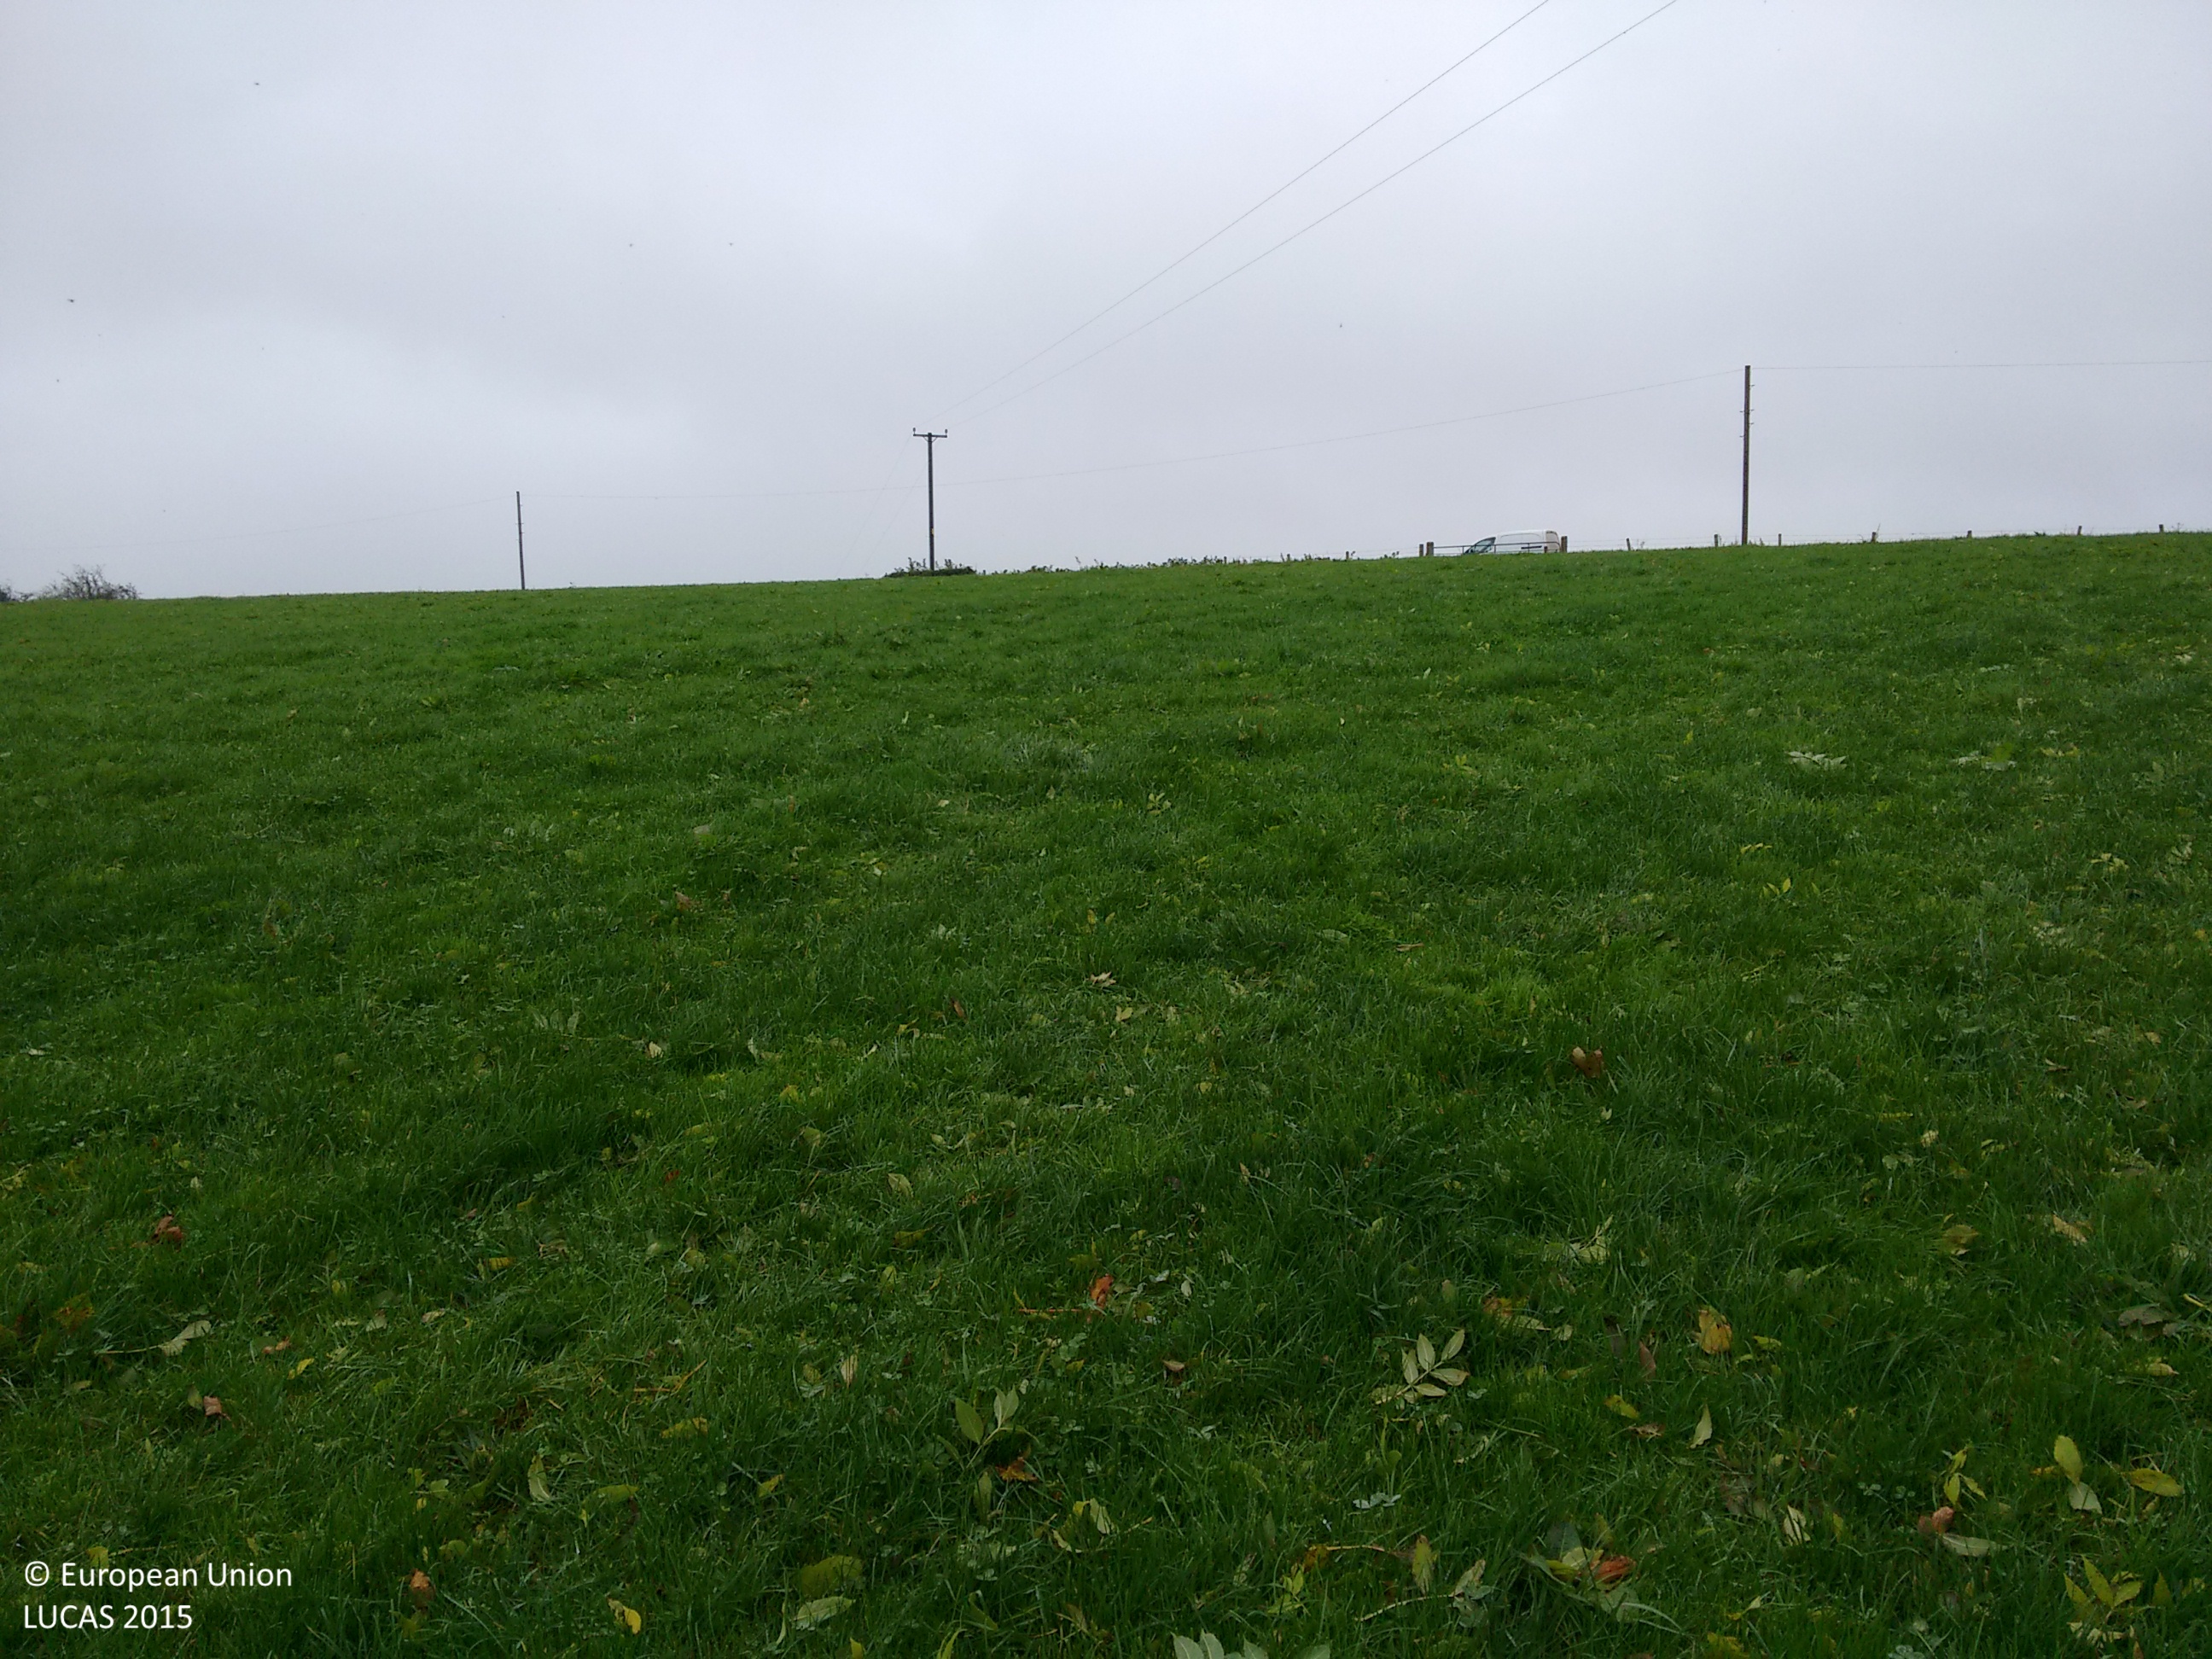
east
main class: Grassland
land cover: Grassland without tree/shrub cover
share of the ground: > 75 %
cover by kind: herbaceous plants 100 %
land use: Agriculture (excluding fallow land and kitchen gardens)
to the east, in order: Grassland without tree/shrub cover; Electric lines; Grassland without tree/shrub cover; Fences; Dry stone walls; Grass margins; Paved roads, cycling and walking lanes; Electric lines; Dry stone walls; Fences; Grassland without tree/shrub cover; Fences; Grassland without tree/shrub cover
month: October
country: GB
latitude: 54.6393
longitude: -7.4931
